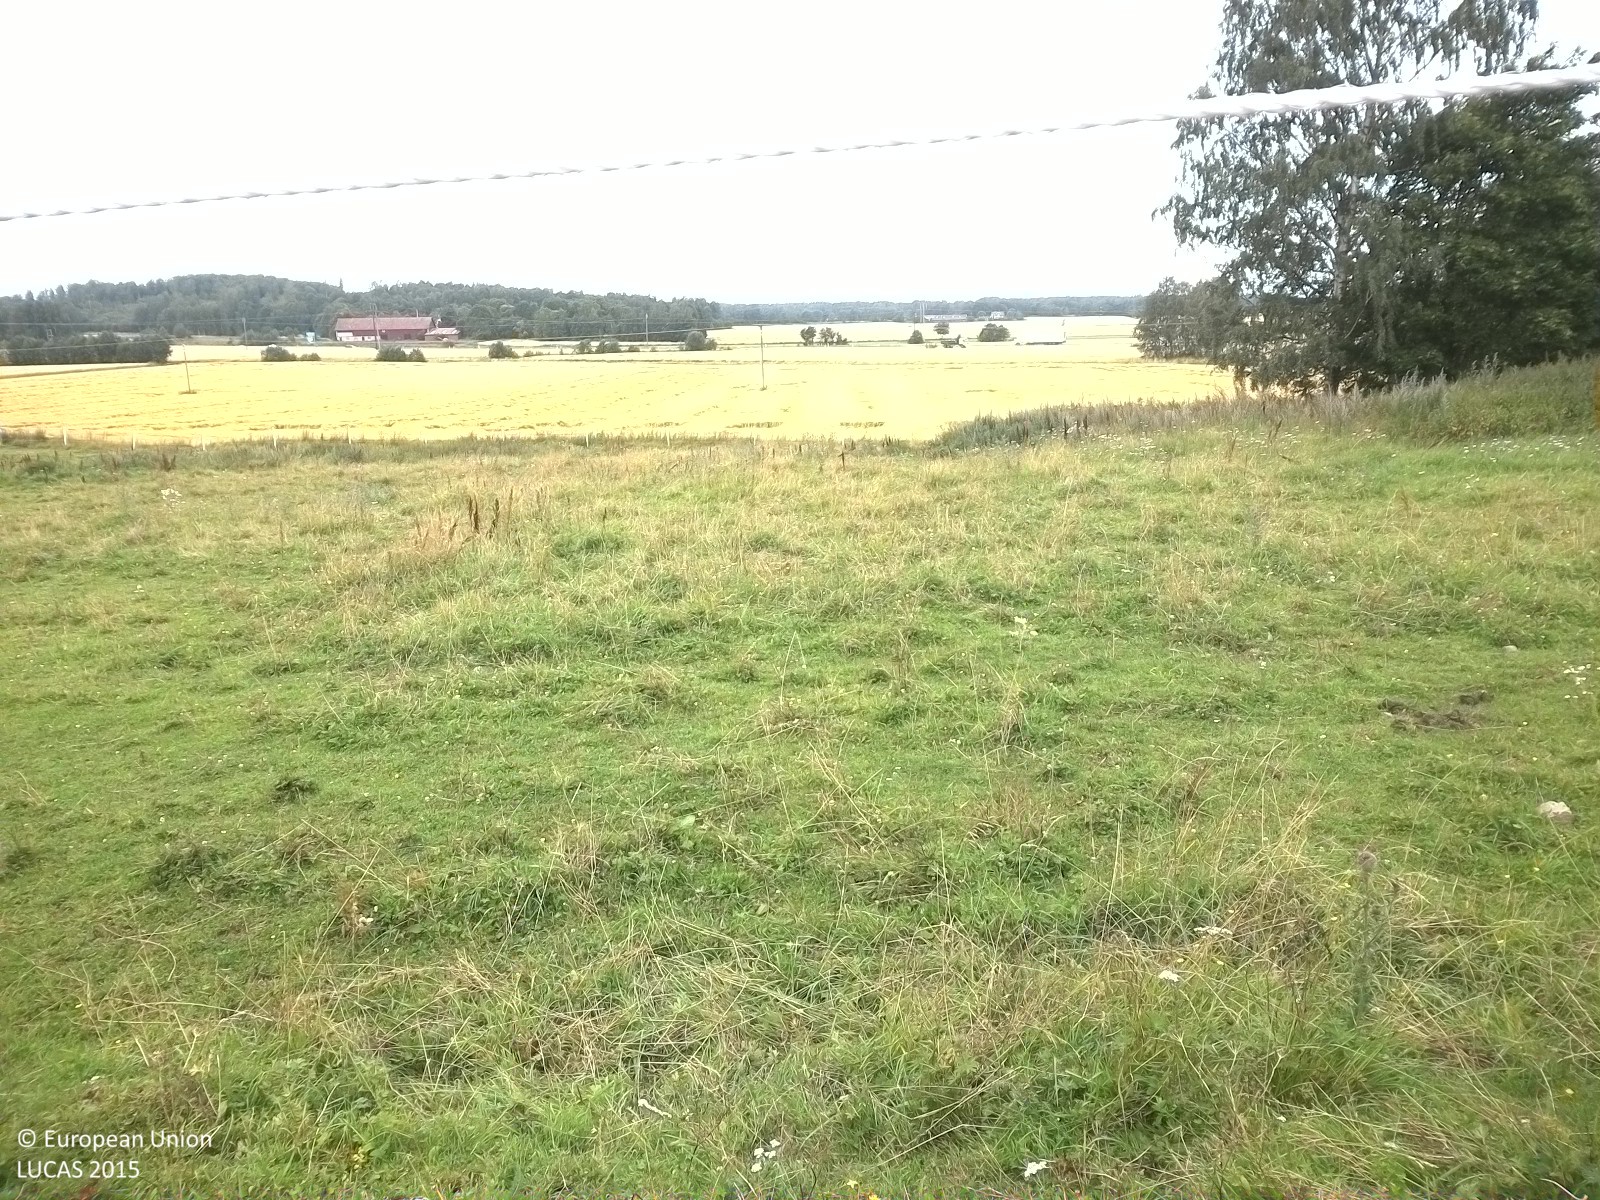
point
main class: Grassland
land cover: Grassland without tree/shrub cover
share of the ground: > 75 %
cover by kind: herbaceous plants 100 %
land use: Agriculture (excluding fallow land and kitchen gardens)
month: August
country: SE
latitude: 59.0808
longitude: 15.0347
